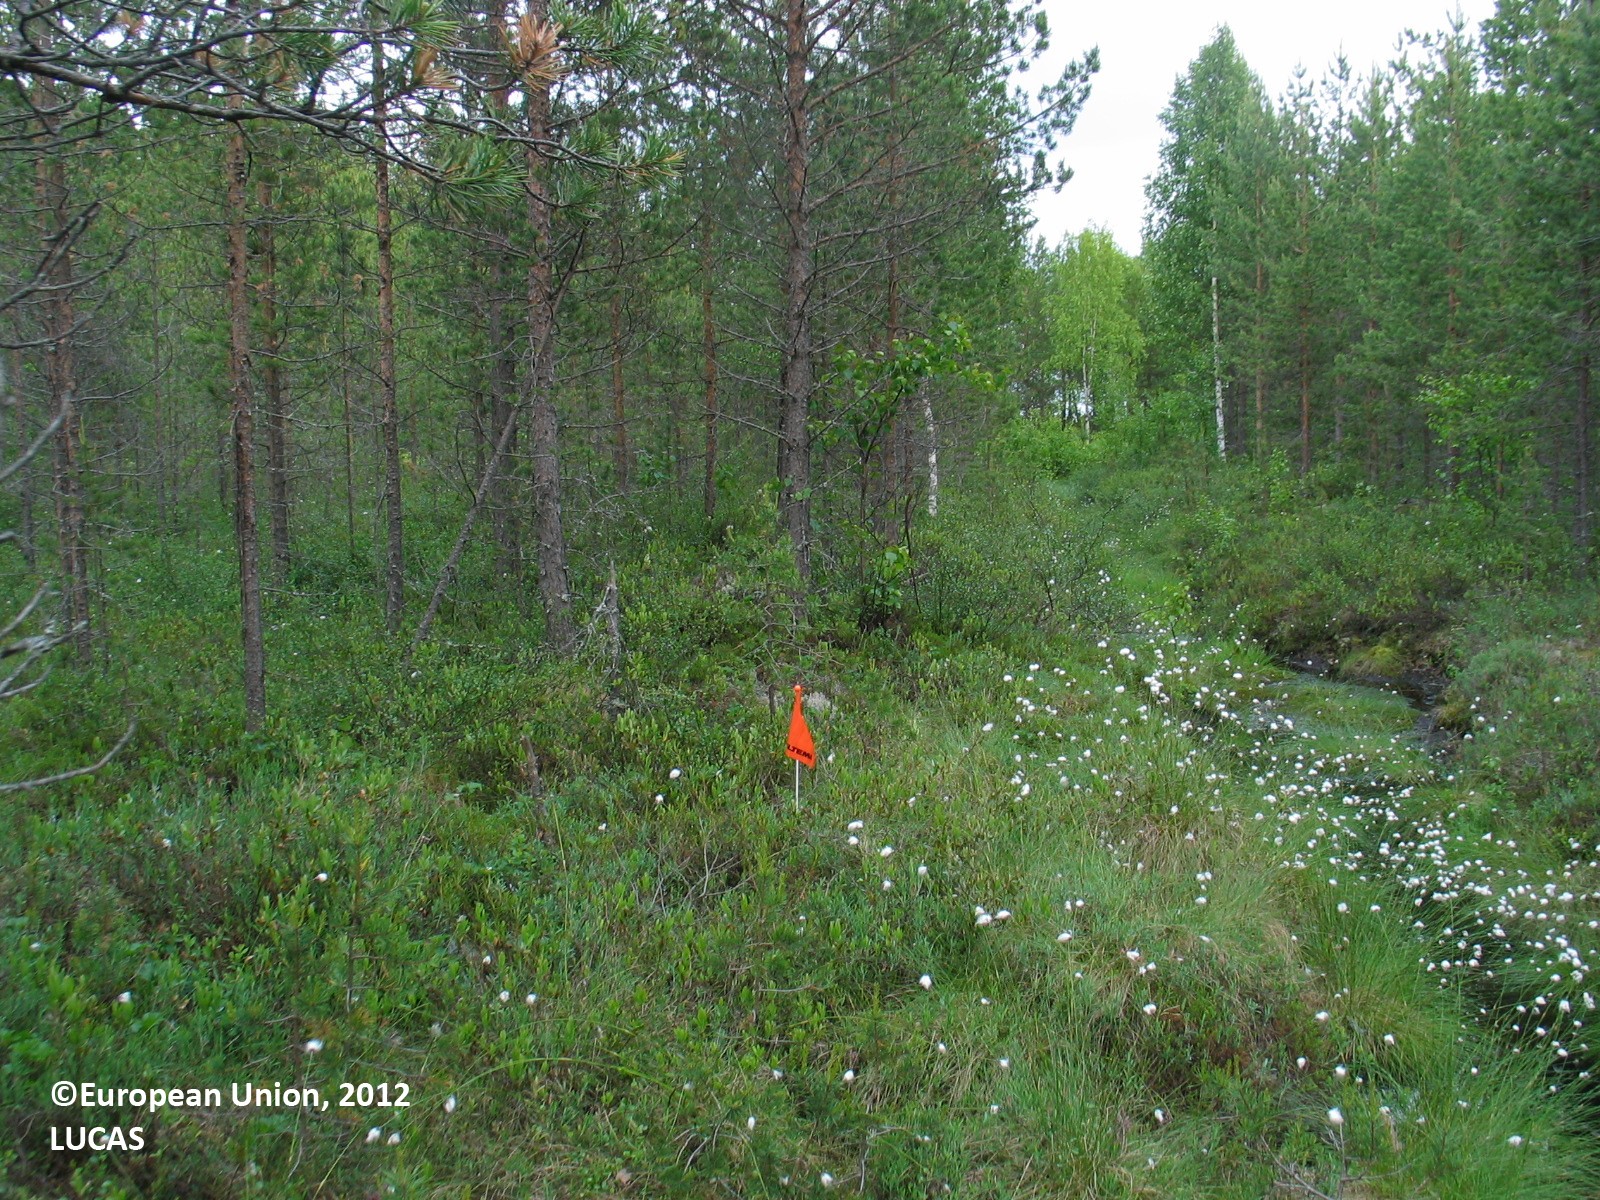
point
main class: Woodland
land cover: Pine dominated coniferous woodland
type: mire and swamp forests
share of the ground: 25 - 50 %
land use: Forestry
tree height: > 5 m
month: June
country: FI
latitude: 64.8725
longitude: 26.2062
